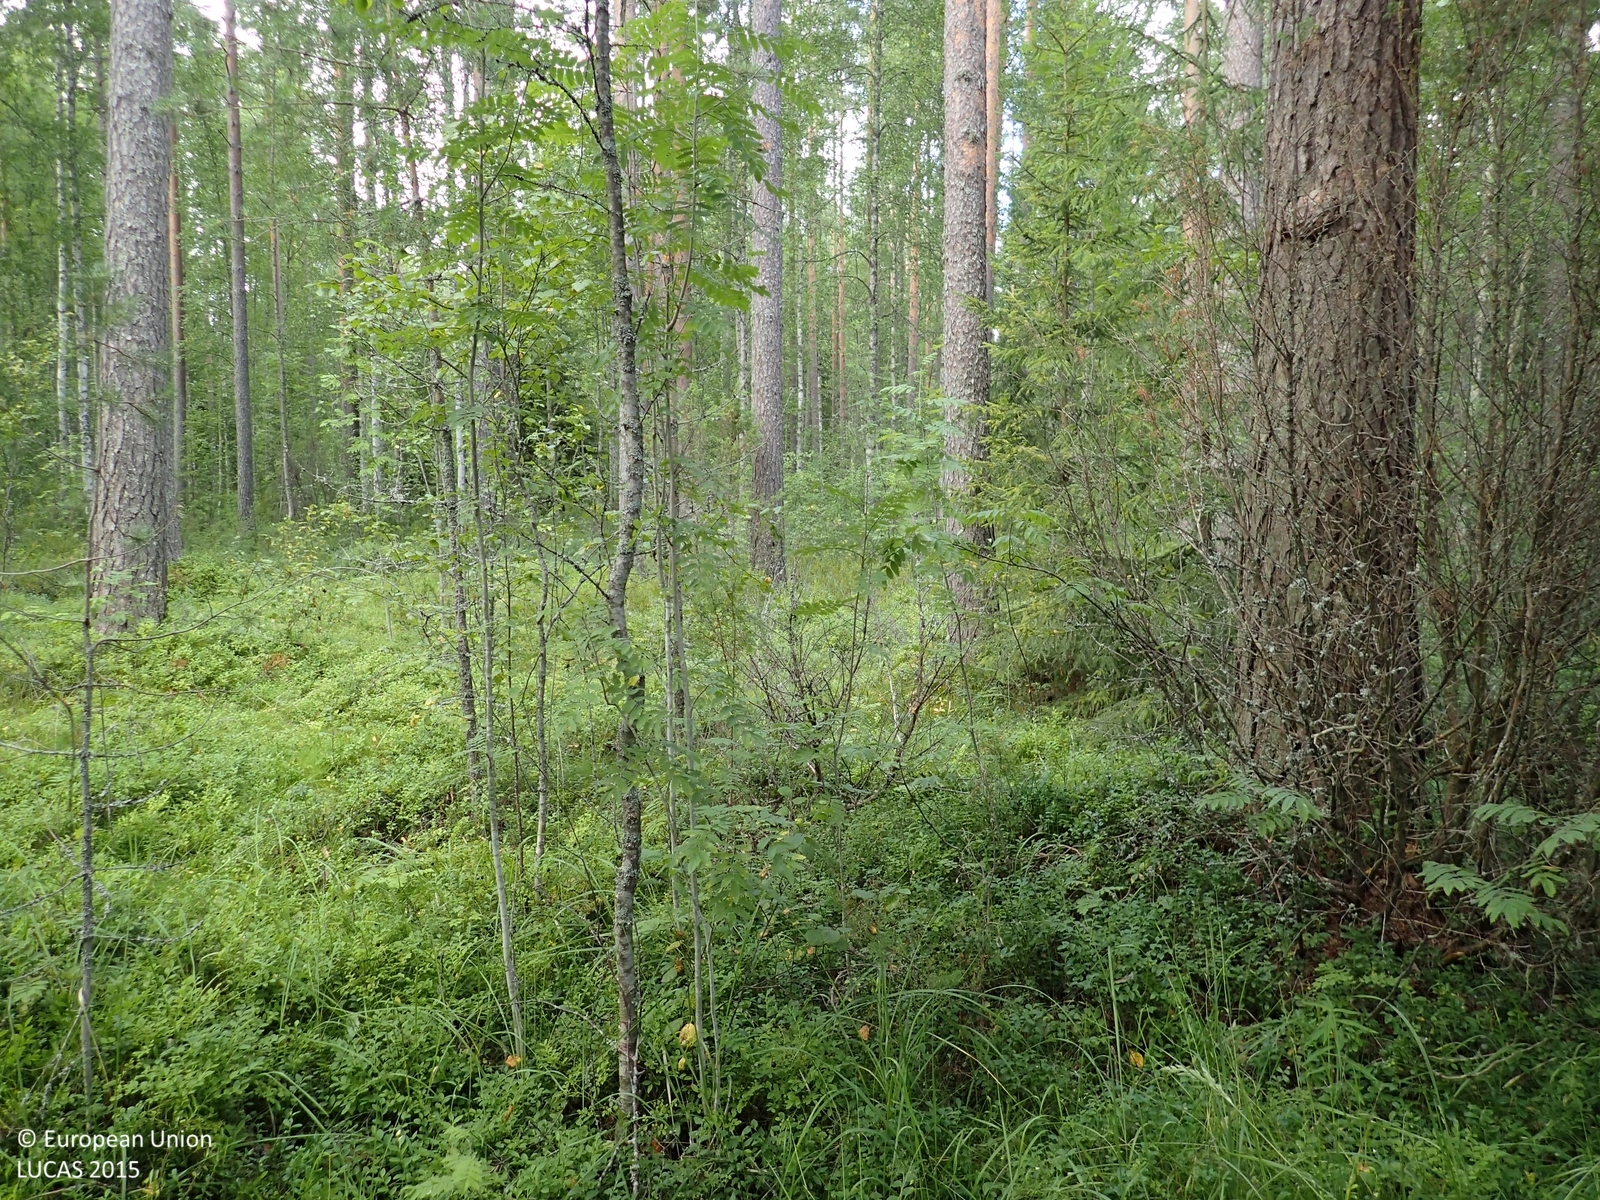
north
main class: Woodland
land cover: Pine dominated mixed woodland
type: boreal forest
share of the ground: > 75 %
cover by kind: coniferous forest trees 60 %, broadleaved forest trees 20 %, shrubs 15 %, herbaceous plants 5 %
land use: Forestry
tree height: > 5 m
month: August
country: FI
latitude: 62.6719
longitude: 21.8587
